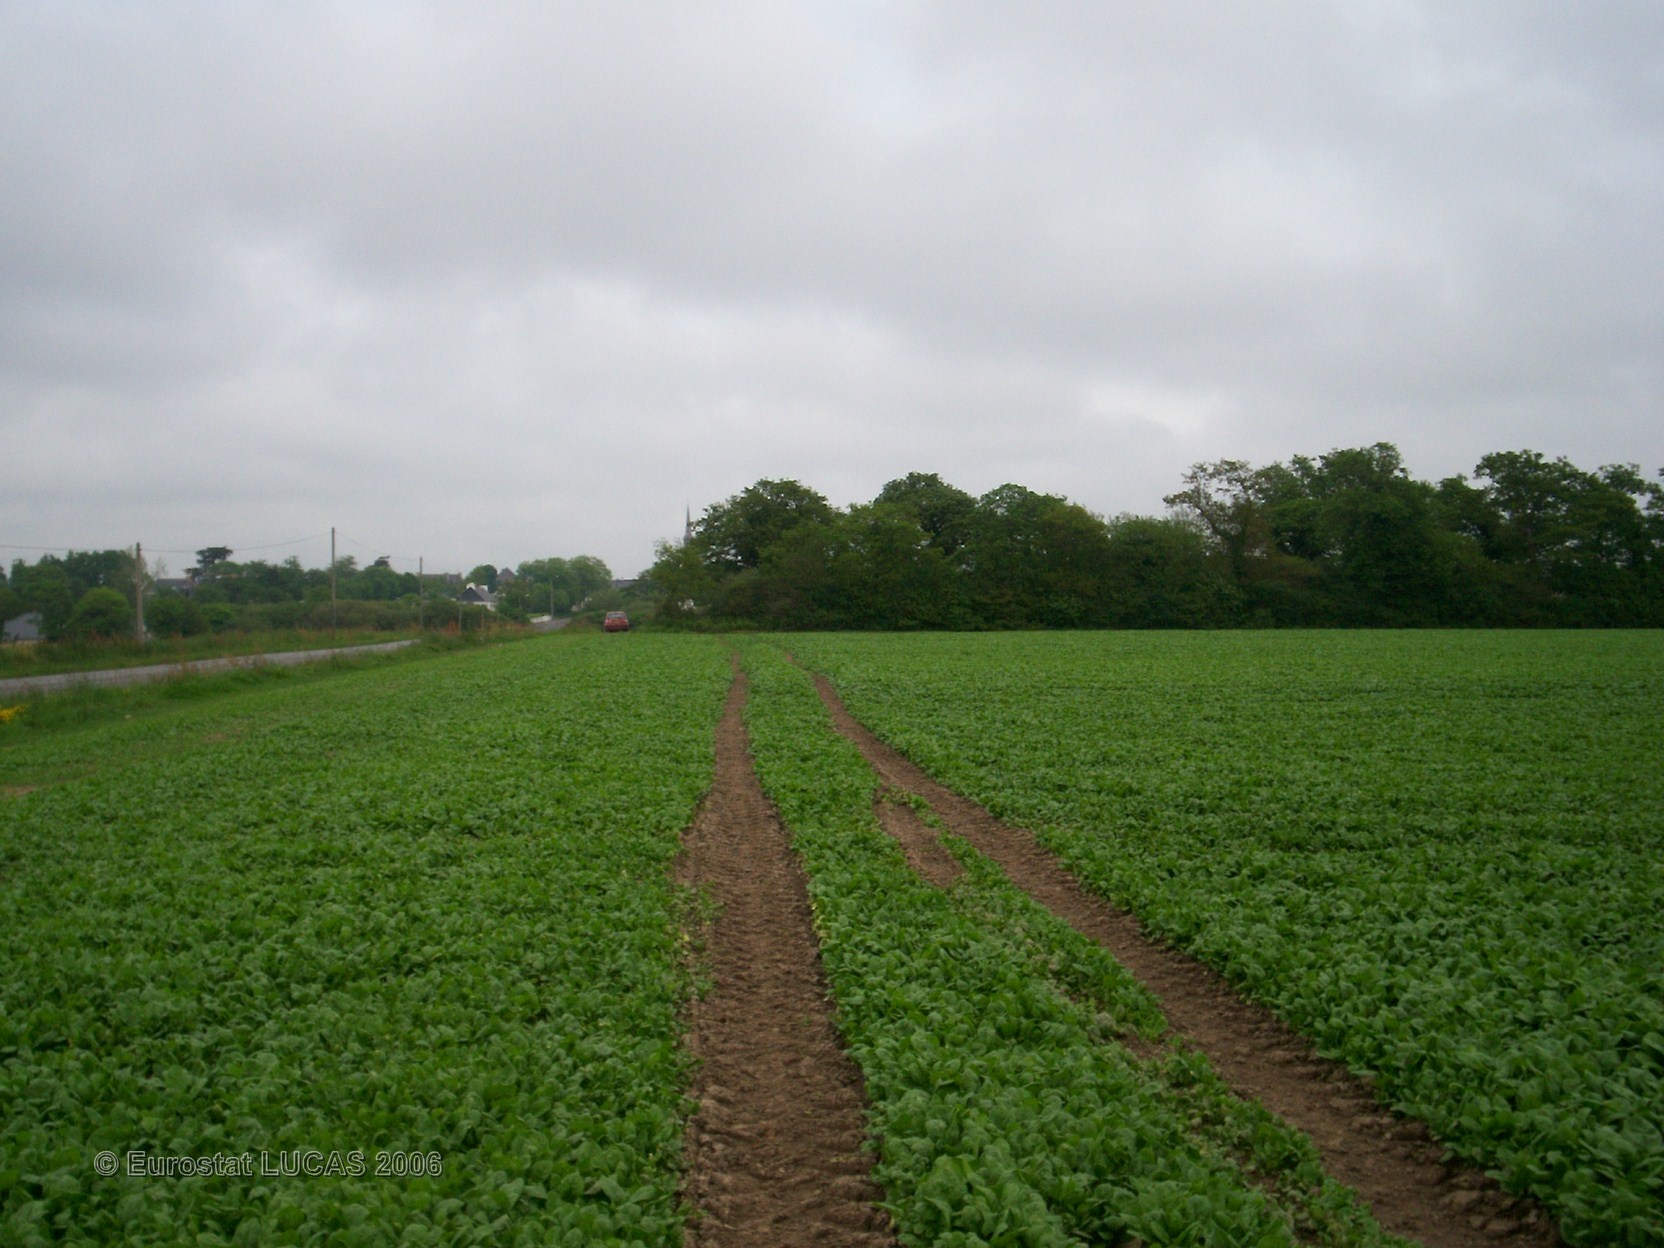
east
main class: Cropland
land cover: Other fresh vegetables
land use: Agriculture (excluding fallow land and kitchen gardens)
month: May
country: FR
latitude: 47.8536
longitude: -3.8619
